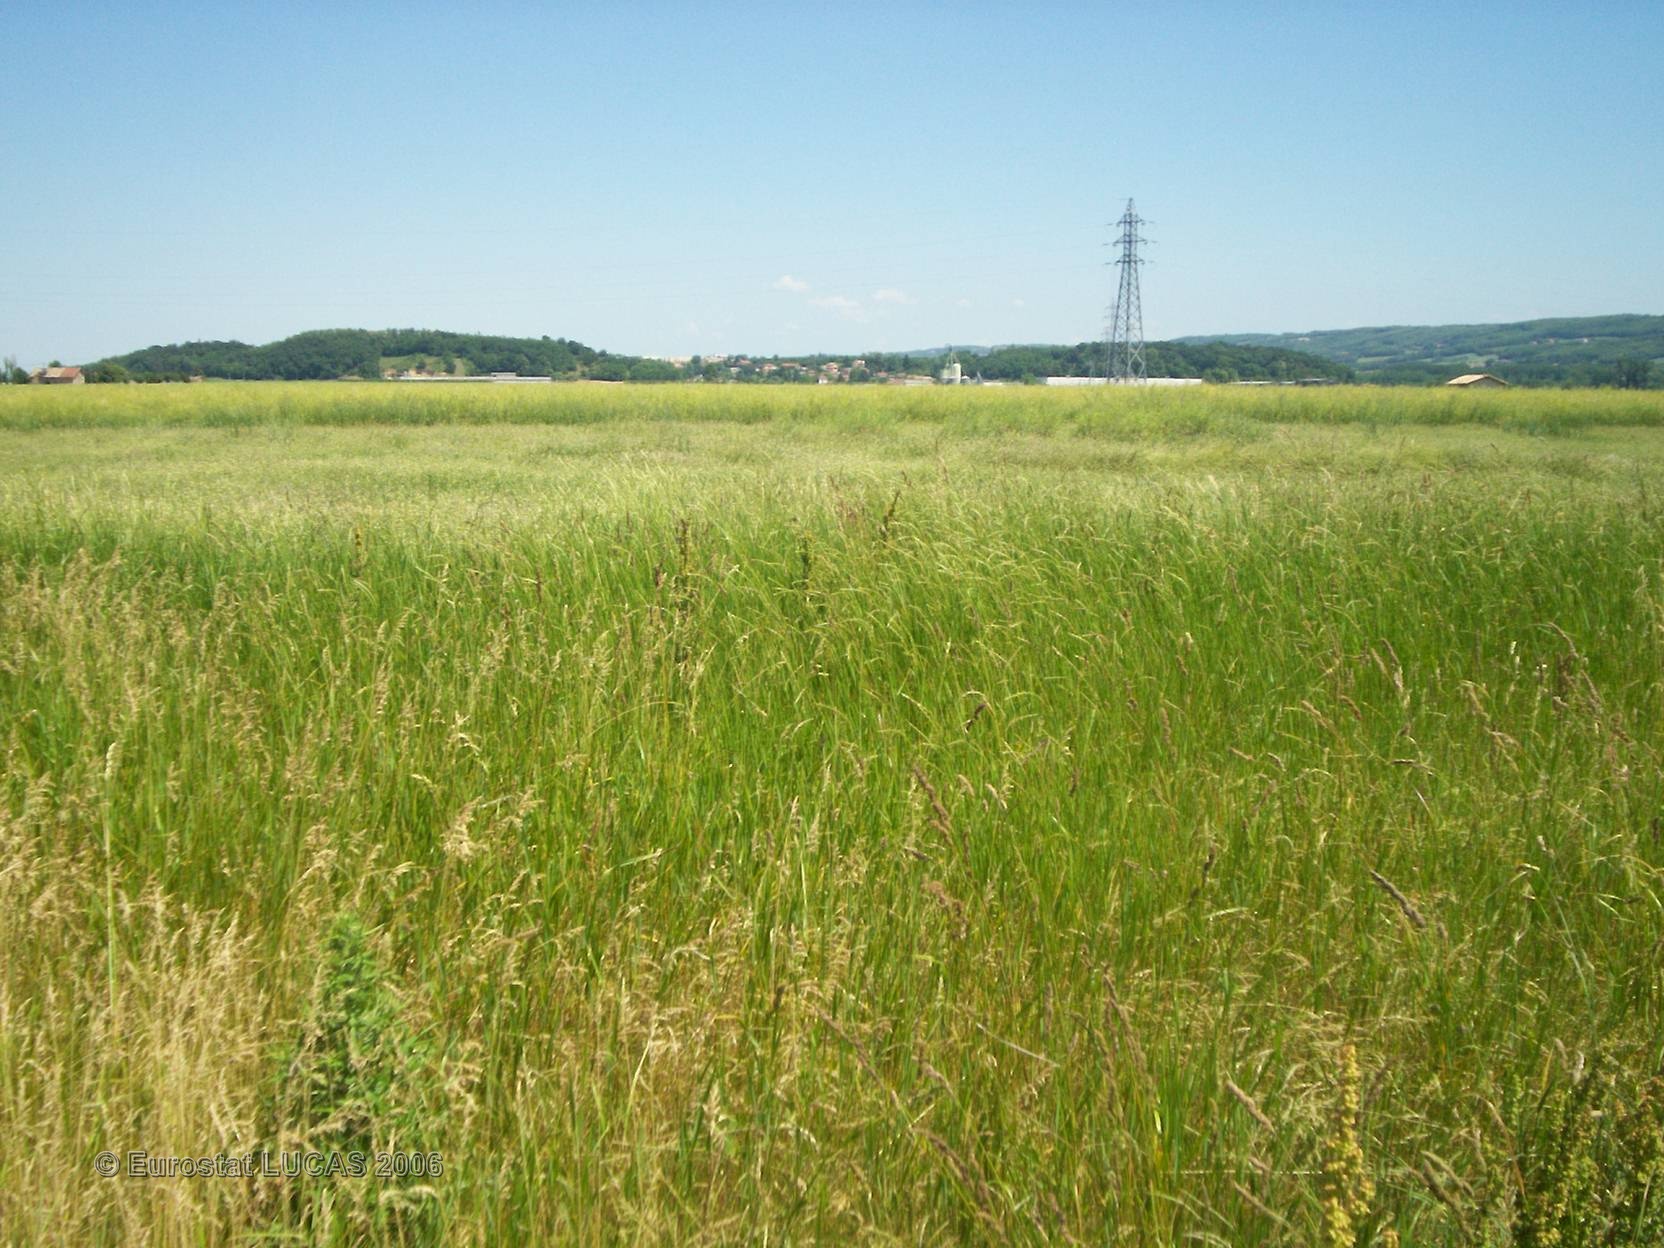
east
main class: Grassland
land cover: Grassland without tree/shrub cover
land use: Agriculture (excluding fallow land and kitchen gardens)
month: June
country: FR
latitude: 45.2700
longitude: 4.8427
